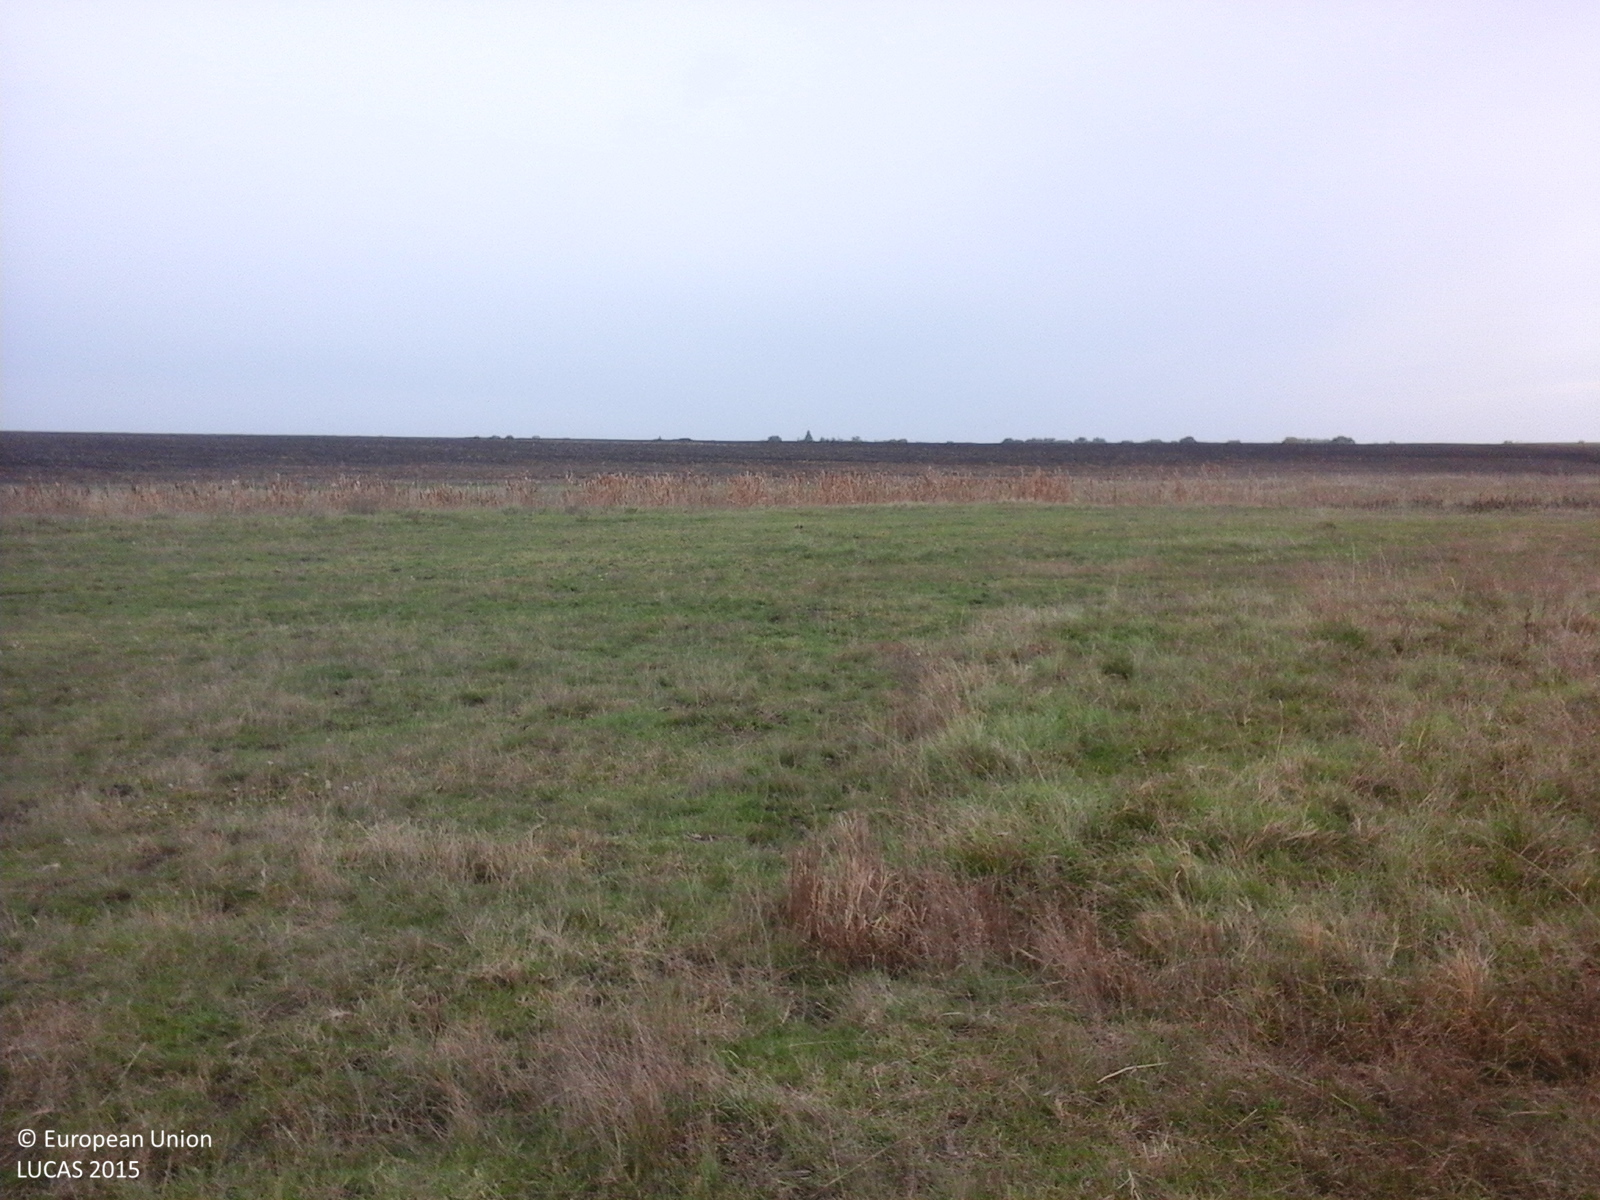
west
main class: Grassland
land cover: Grassland without tree/shrub cover
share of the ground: > 75 %
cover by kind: herbaceous plants 100 %
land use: Agriculture (excluding fallow land and kitchen gardens)
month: October
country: RO
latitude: 44.9141
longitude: 26.3682
